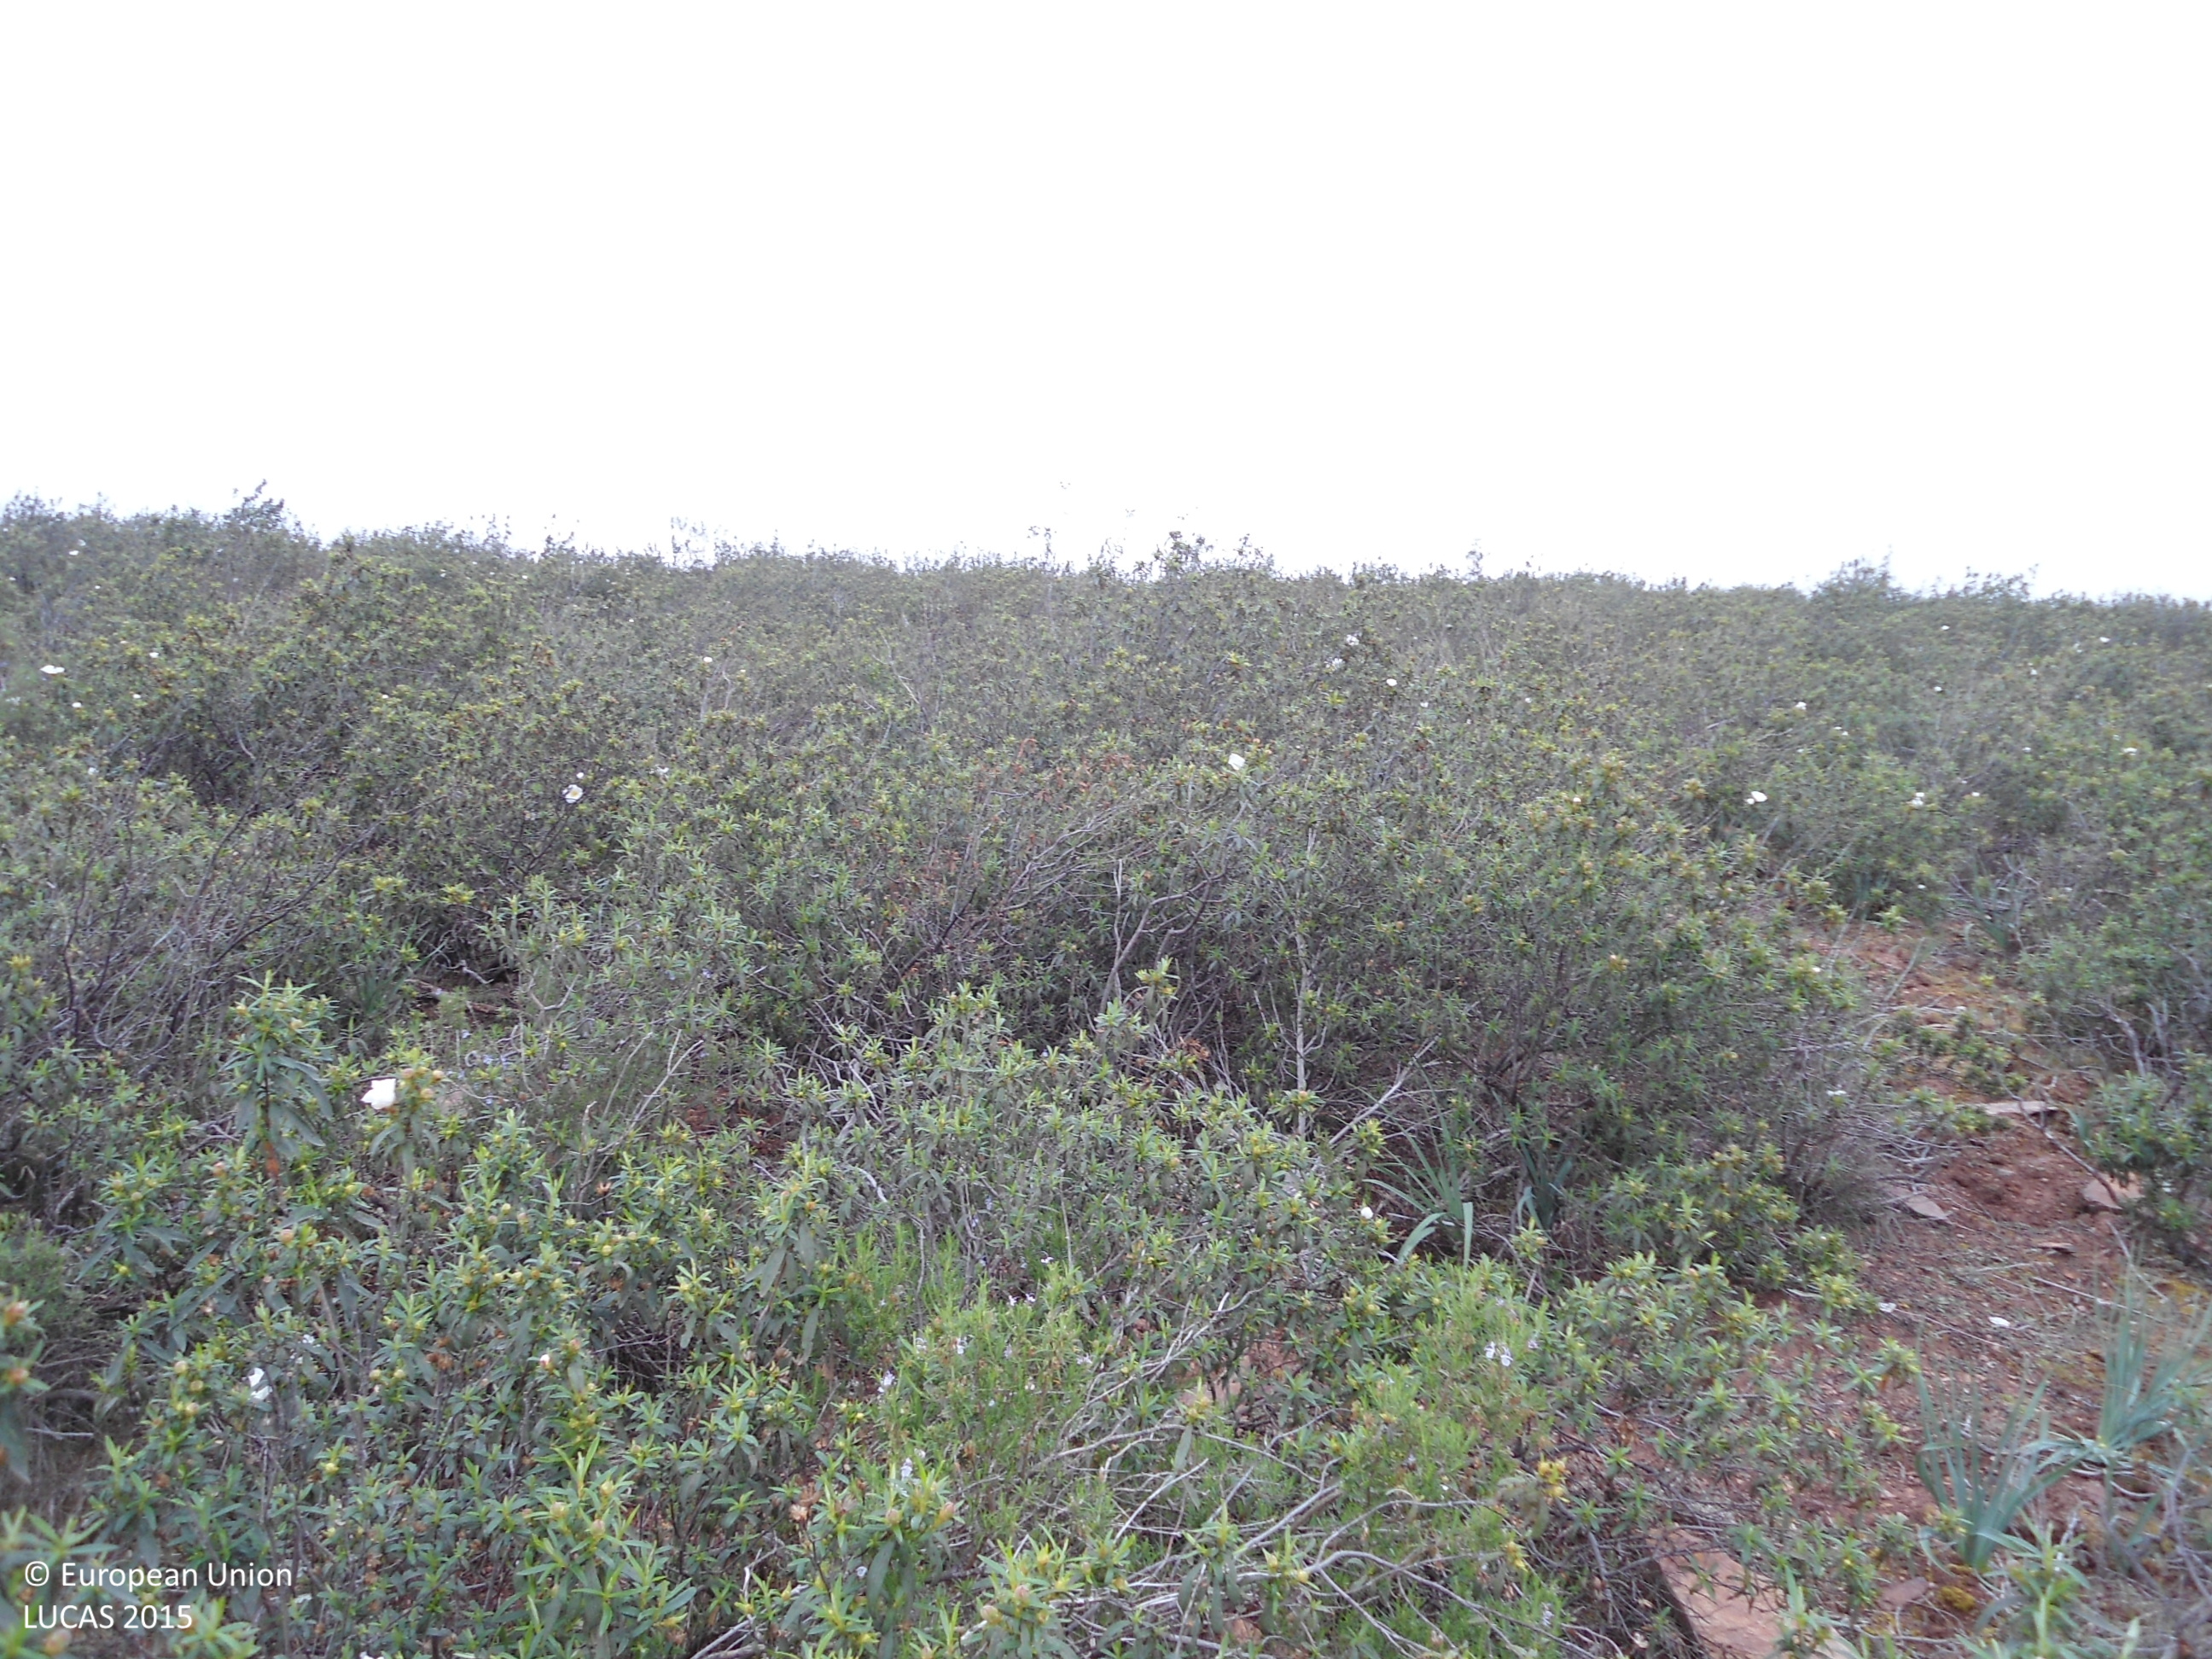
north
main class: Shrubland
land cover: Shrubland without tree cover
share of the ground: > 75 %
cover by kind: shrubs 100 %
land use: Abandoned areas
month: April
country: ES
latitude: 41.5256
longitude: -5.8481
